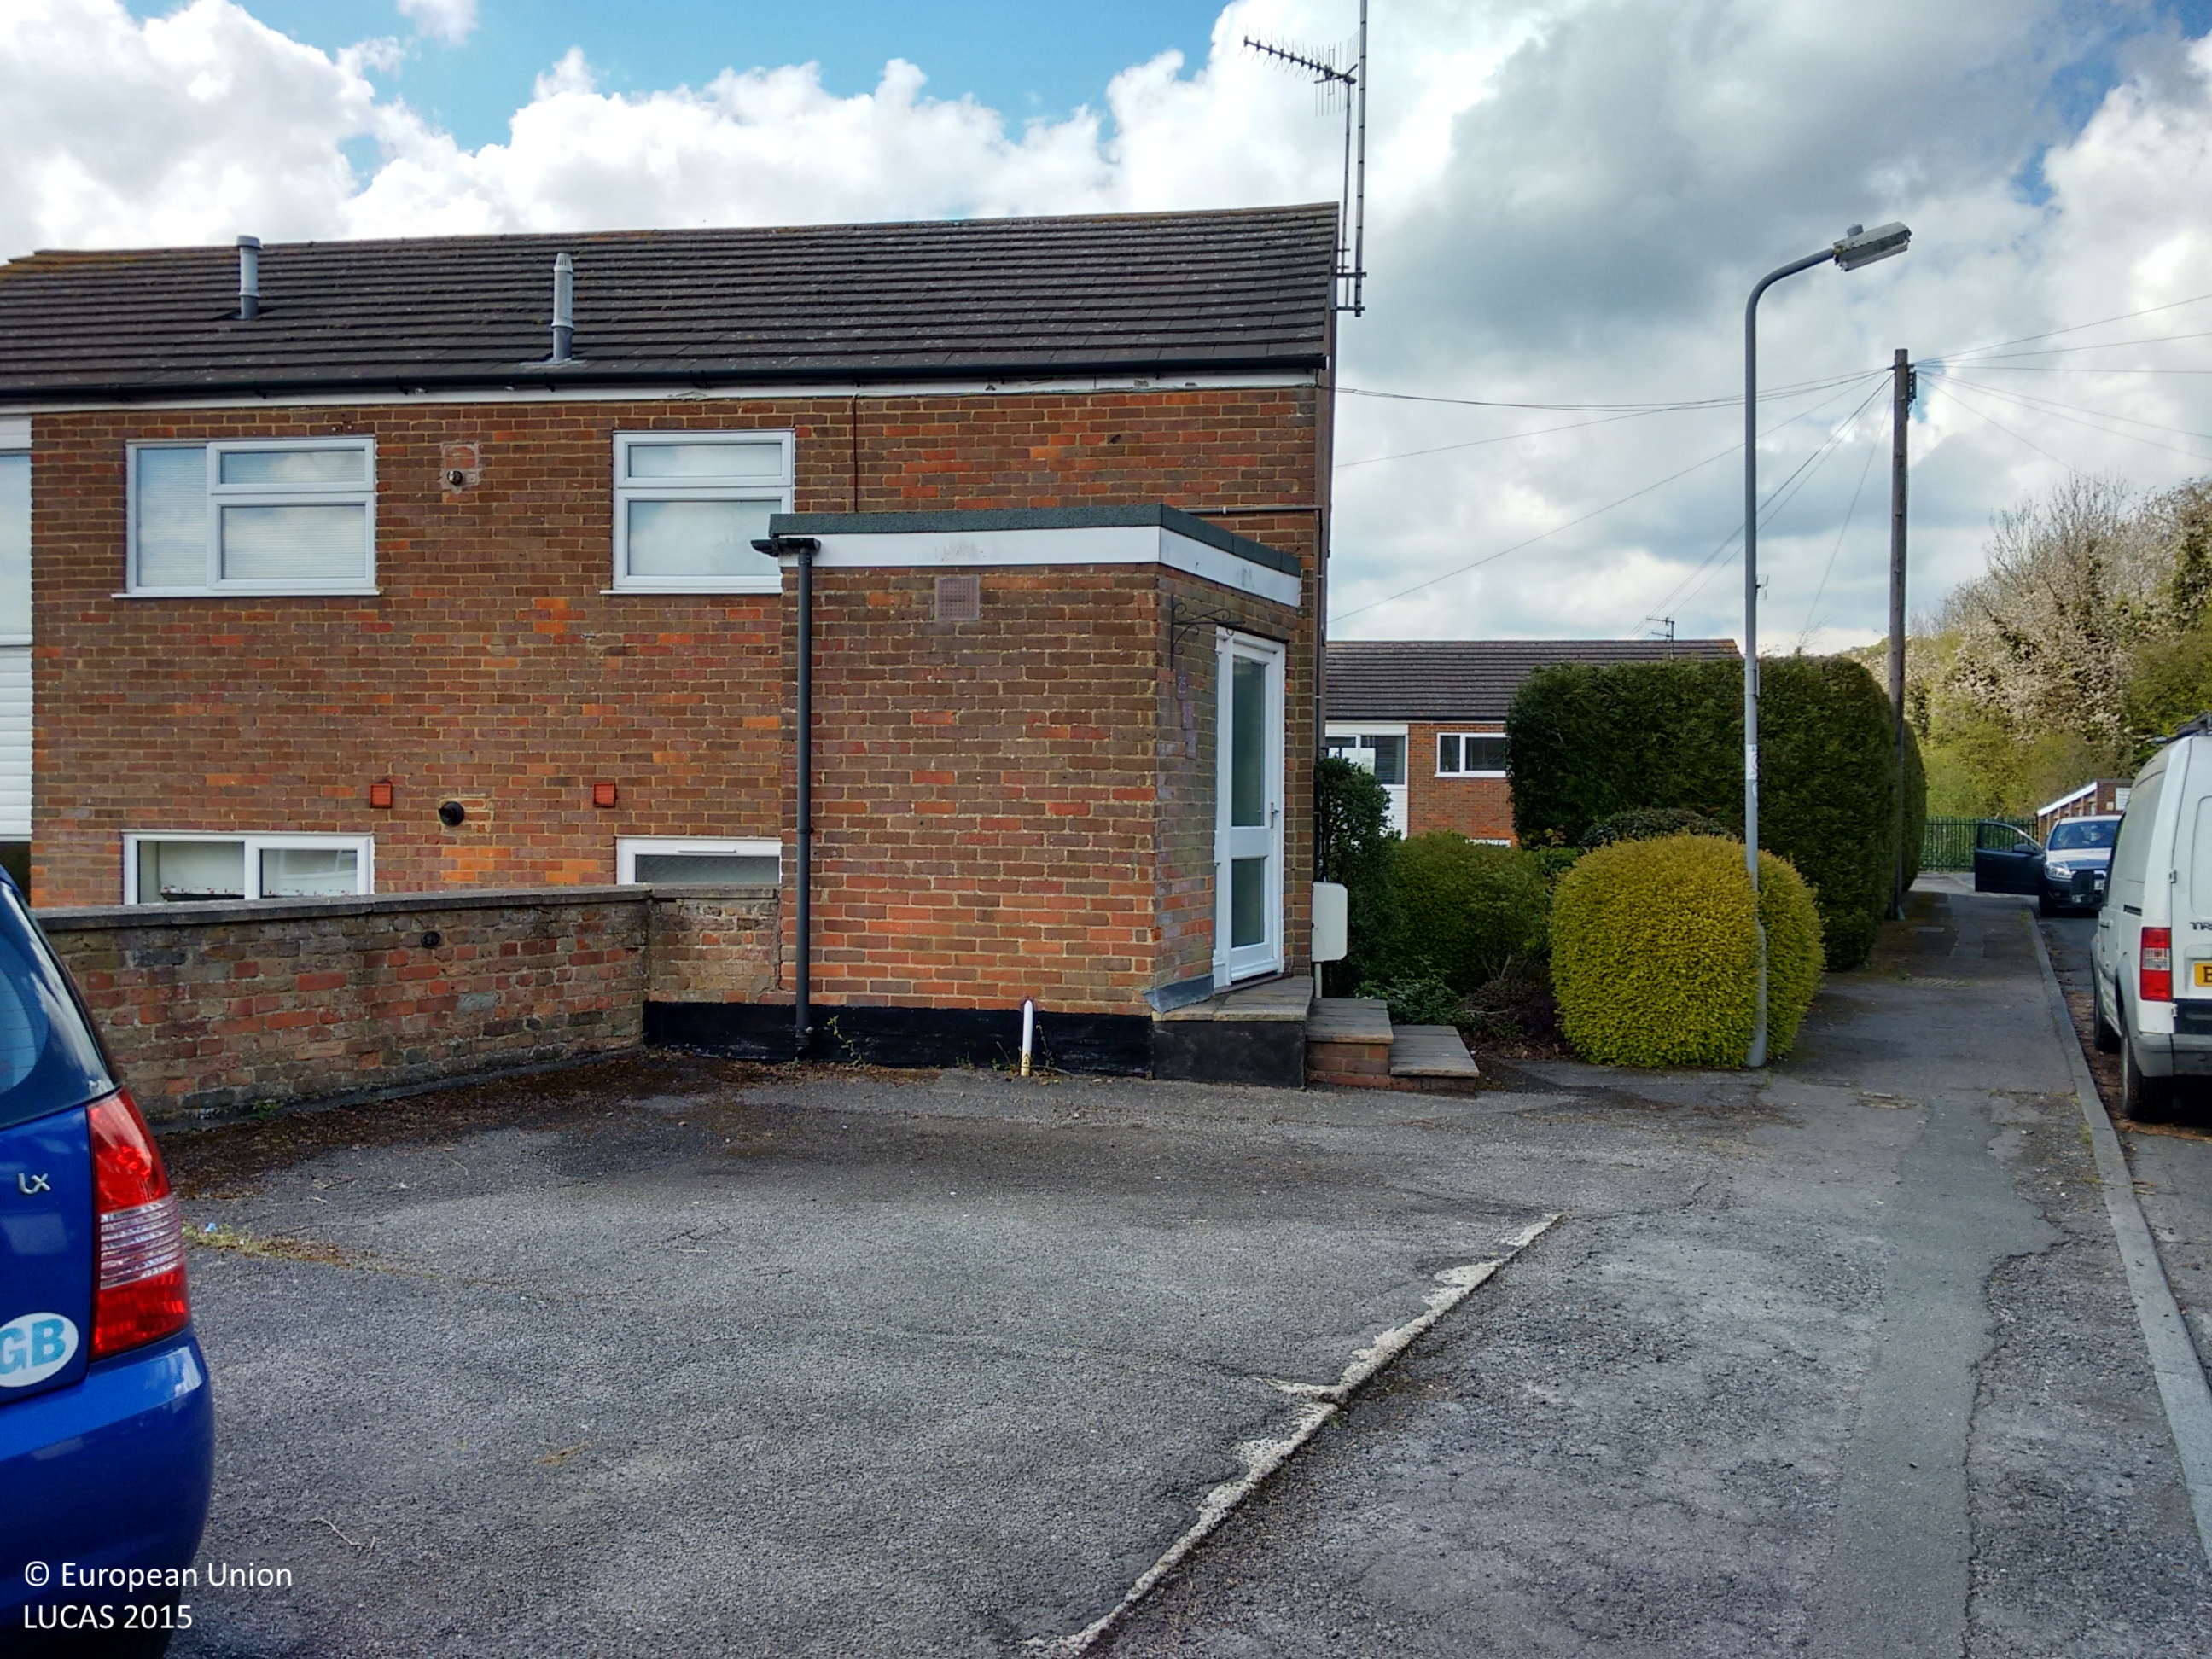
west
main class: Woodland
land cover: Broadleaved woodland
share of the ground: > 75 %
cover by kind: broadleaved forest trees 50 %, herbaceous plants 50 %
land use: Residential
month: April
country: GB
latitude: 51.7182
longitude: -0.6209
